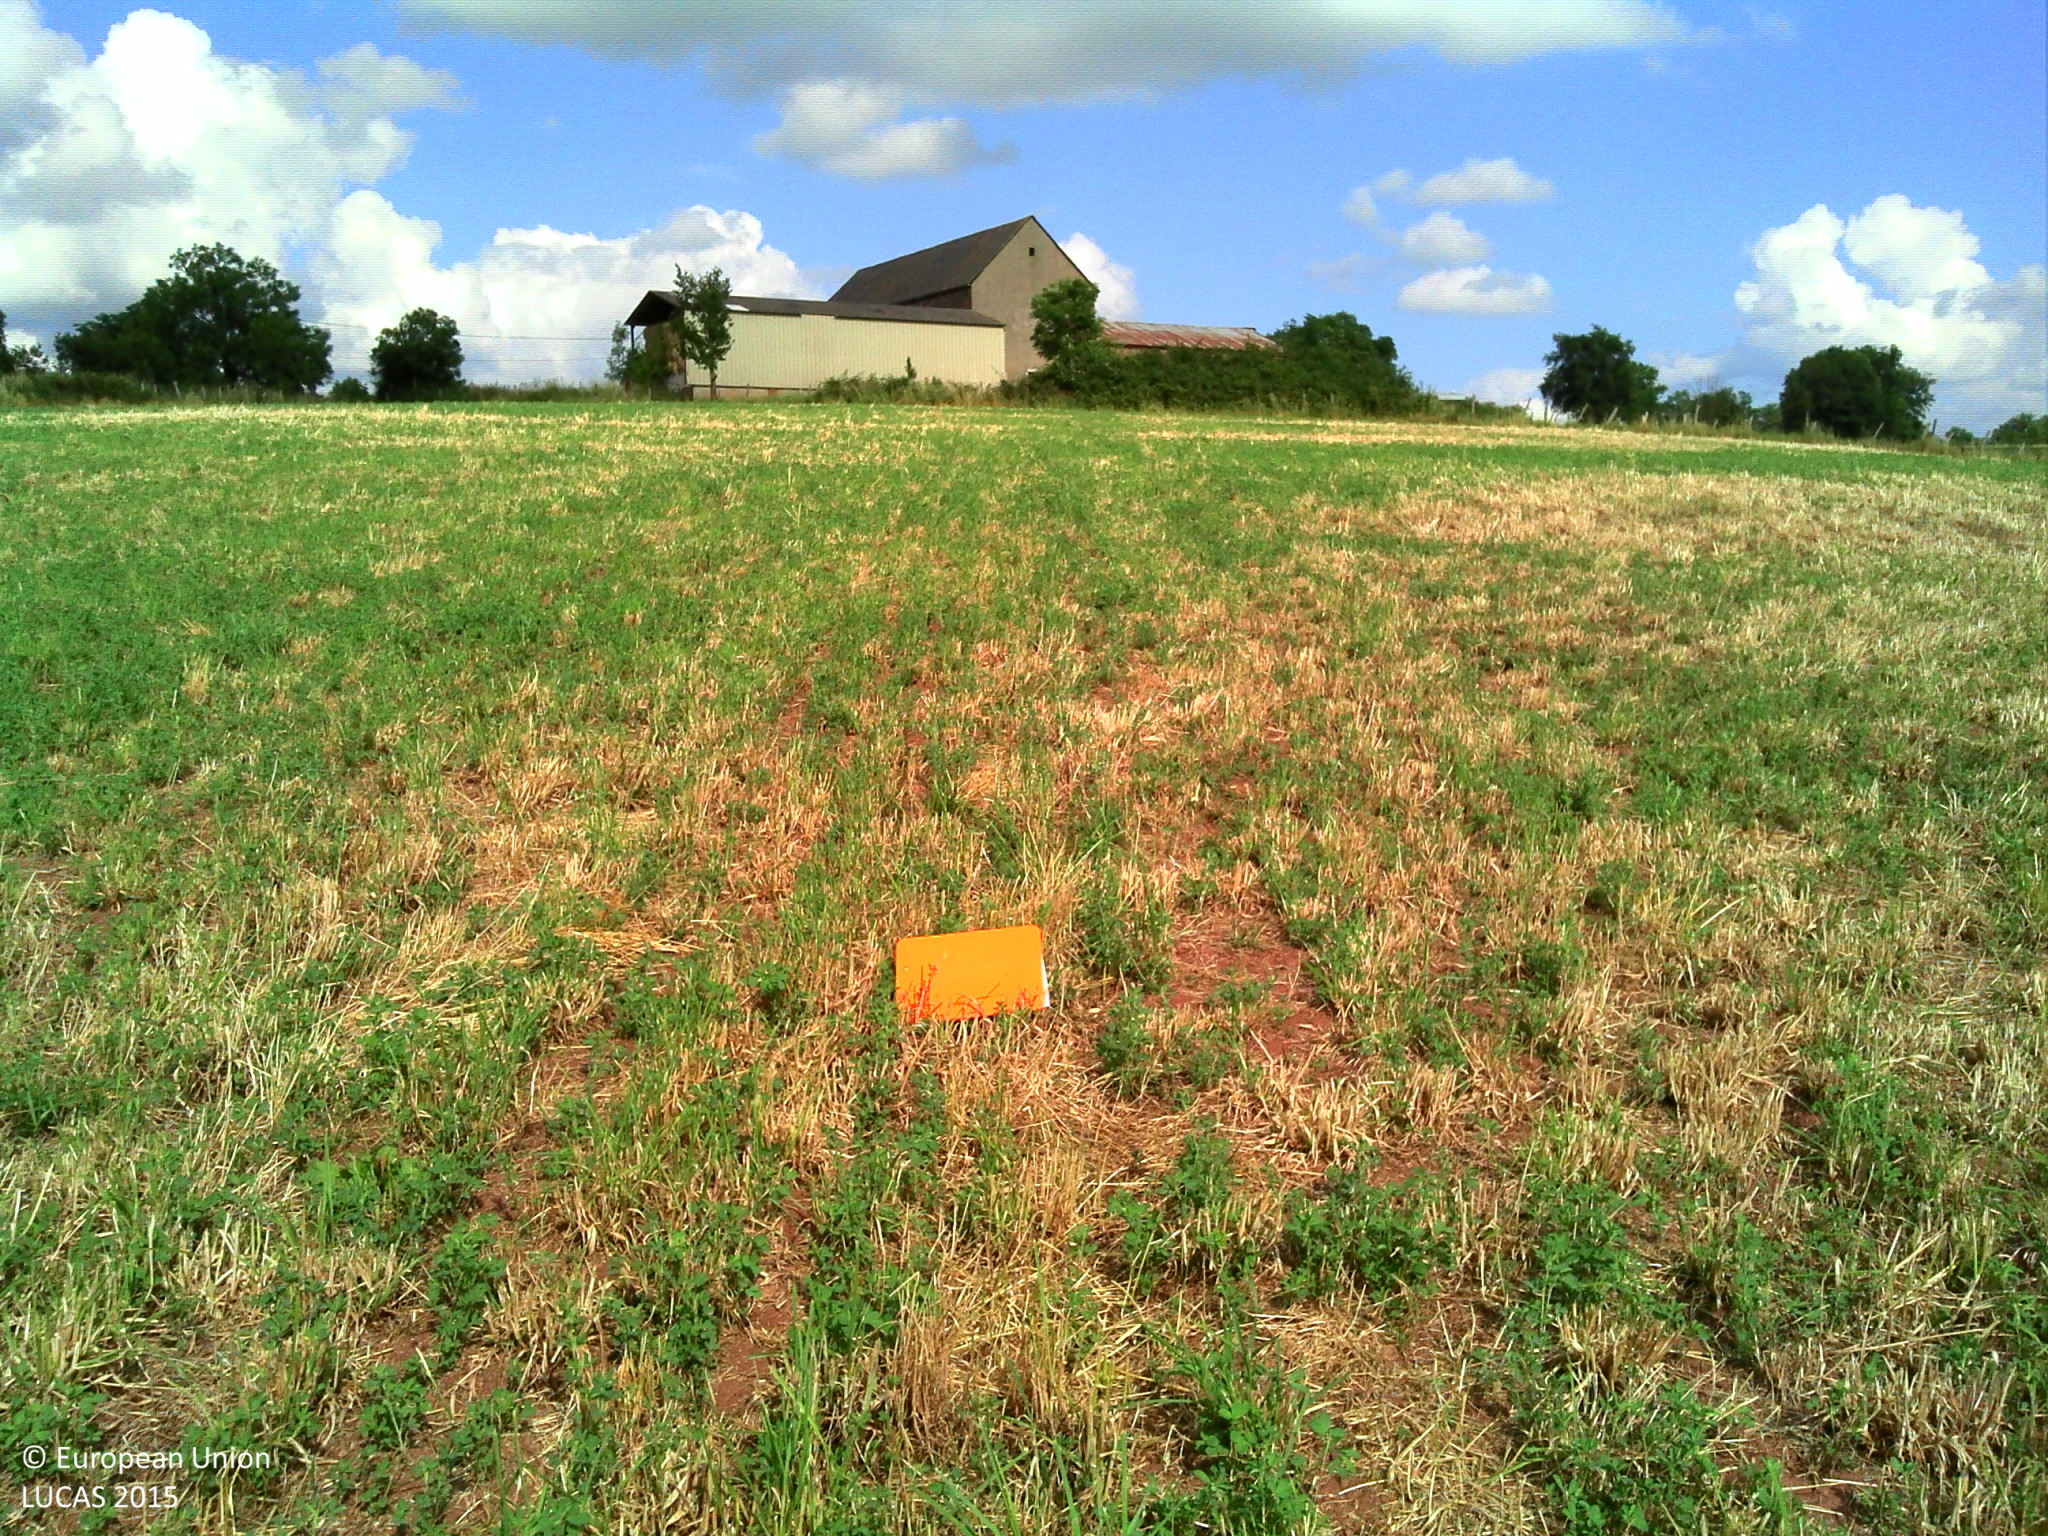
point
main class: Cropland
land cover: Lucerne
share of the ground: 50 - 75 %
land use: Agriculture (excluding fallow land and kitchen gardens)
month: June
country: FR
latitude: 44.3372
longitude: 2.5659
